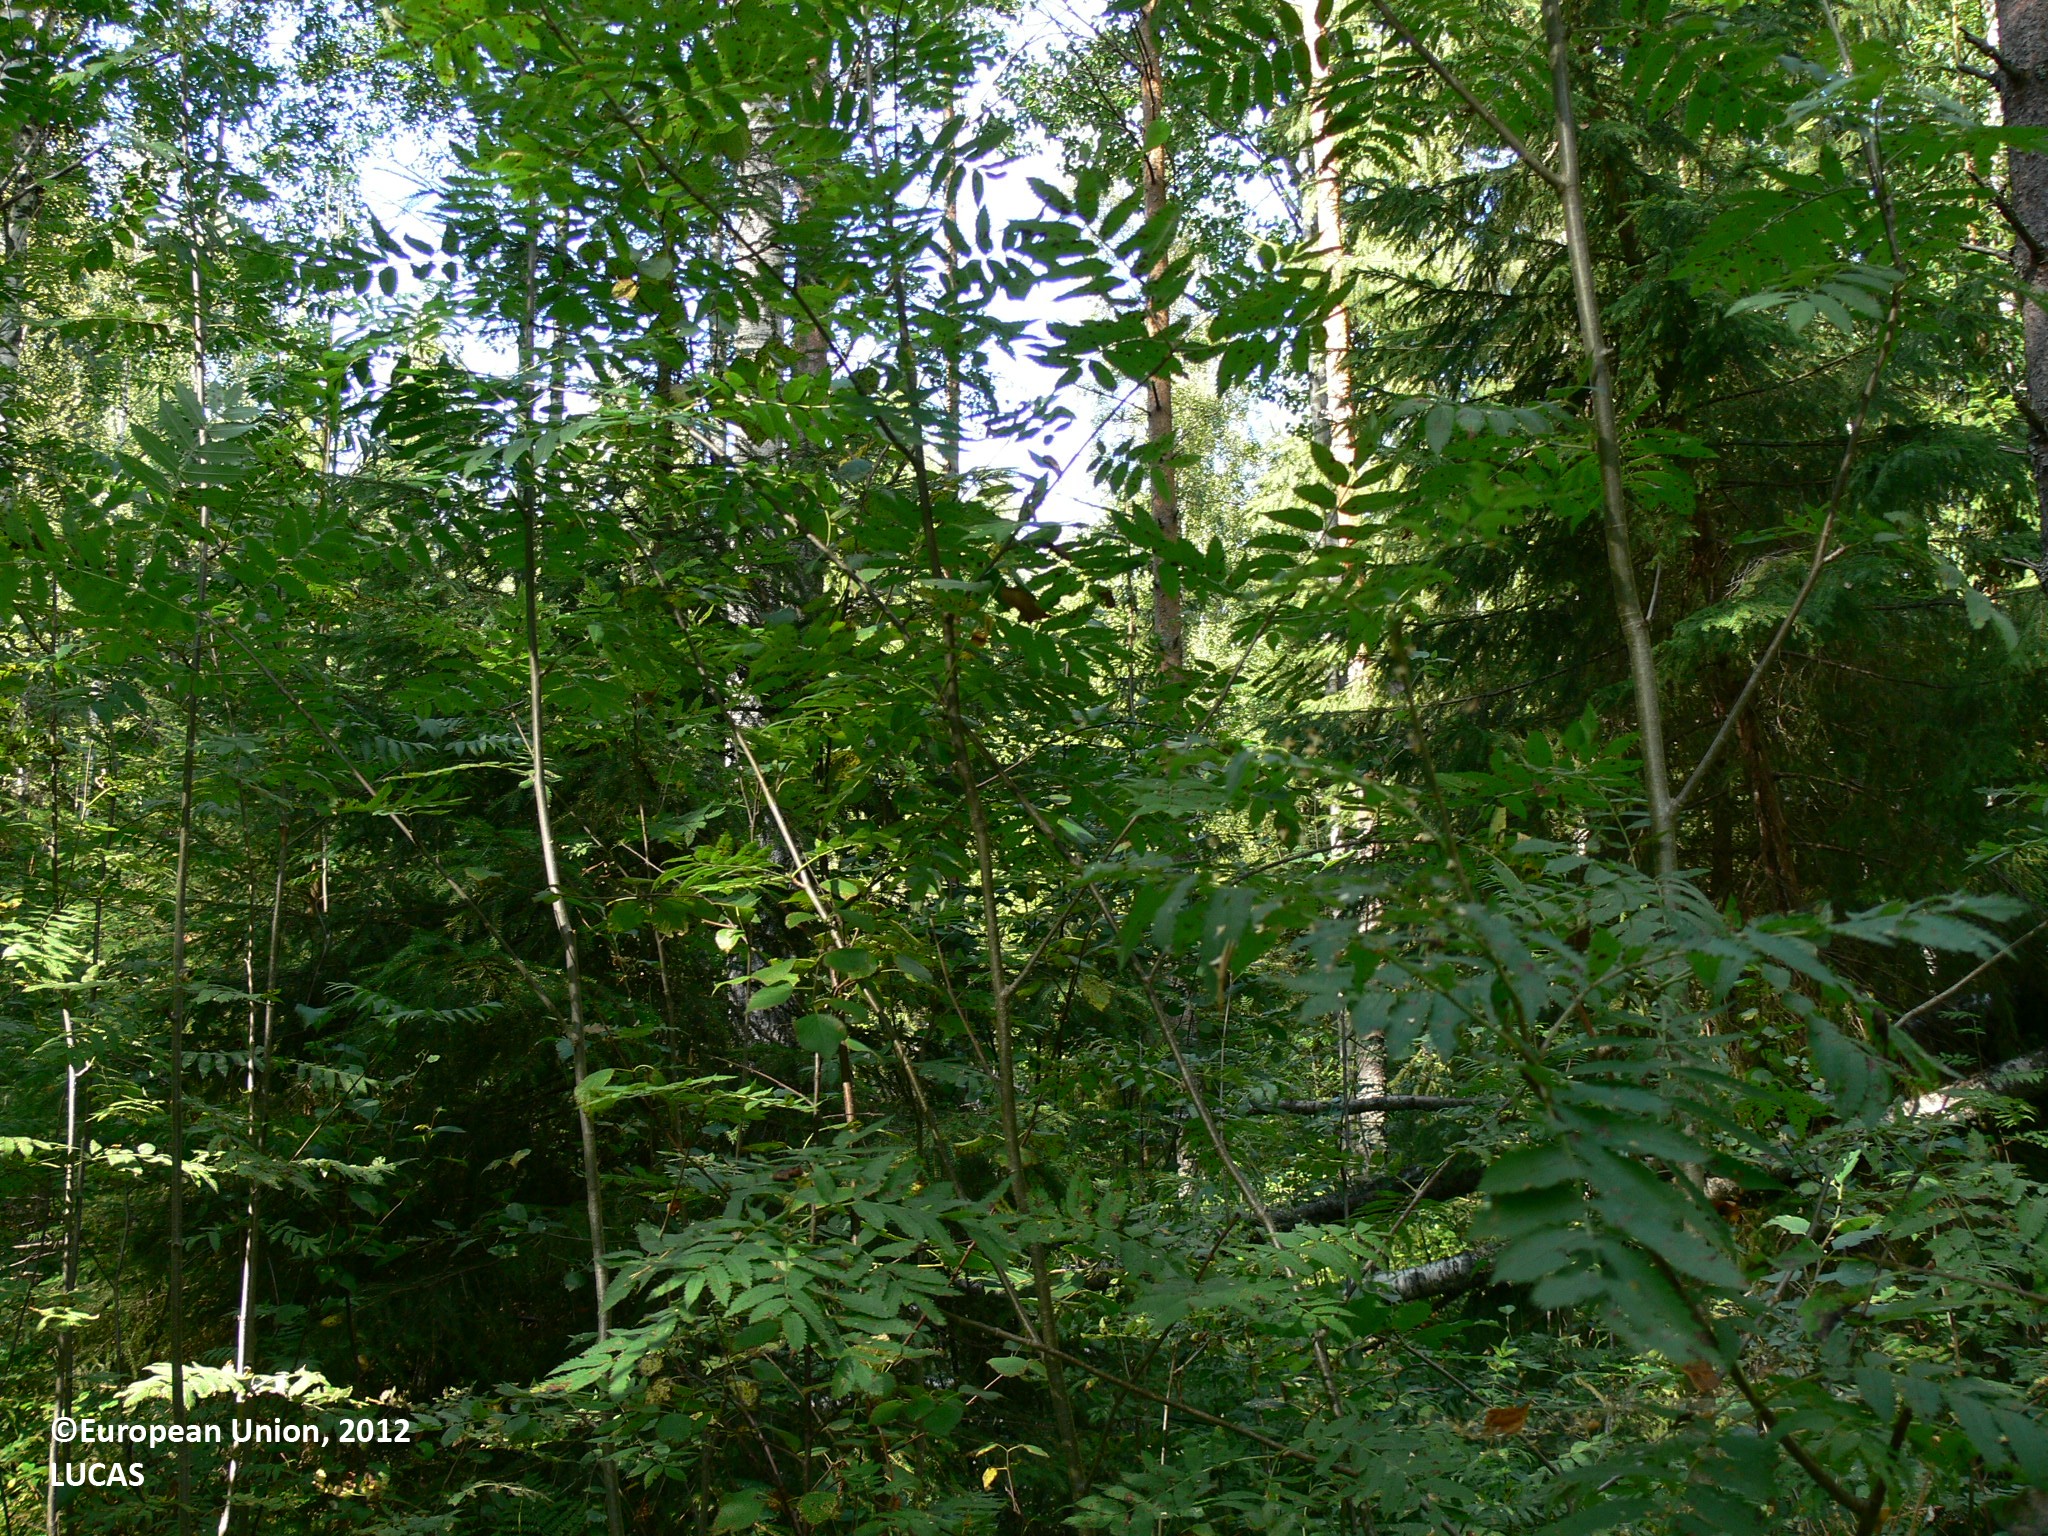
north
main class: Woodland
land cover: Other mixed woodland
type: boreal forest
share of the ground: > 75 %
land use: Forestry
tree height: > 5 m
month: August
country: FI
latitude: 61.8058
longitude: 29.1891
